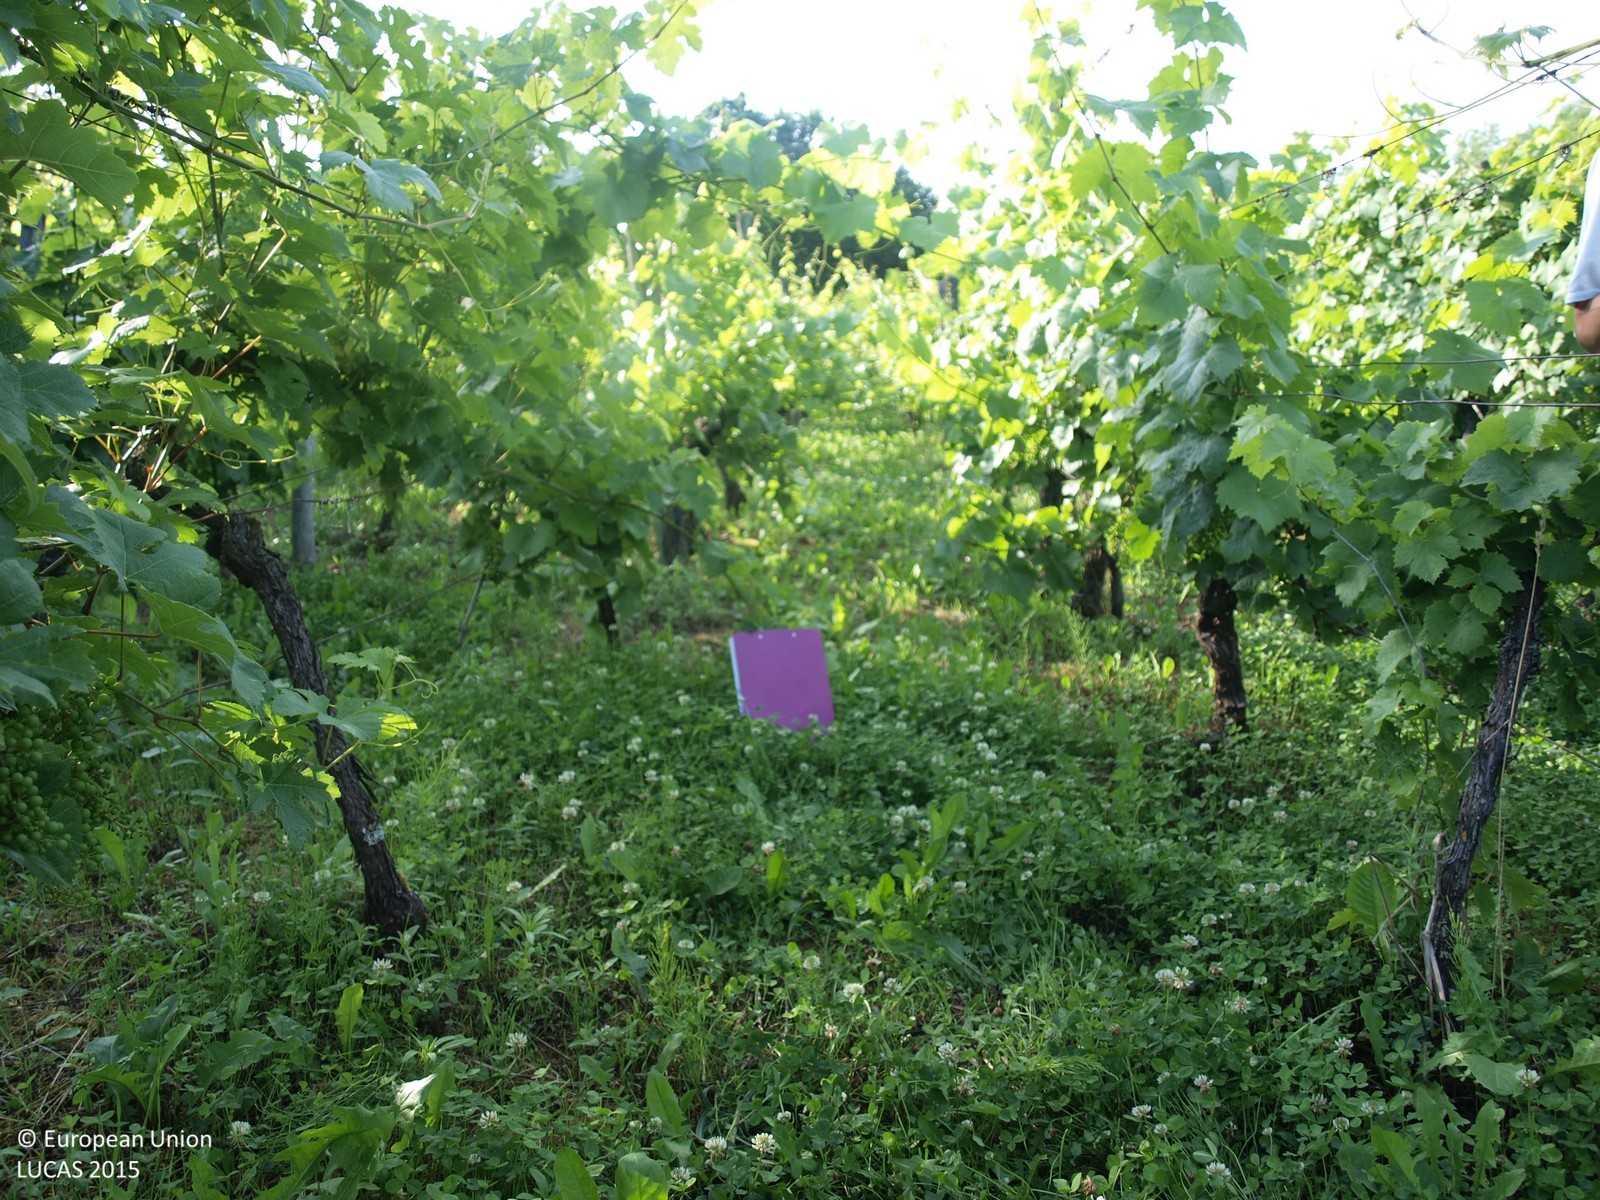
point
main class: Cropland
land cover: Vineyards
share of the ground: > 75 %
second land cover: Grassland without tree/shrub cover
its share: 10 - 25 %
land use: Agriculture (excluding fallow land and kitchen gardens)
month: June
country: HR
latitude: 45.9803
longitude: 15.7419
